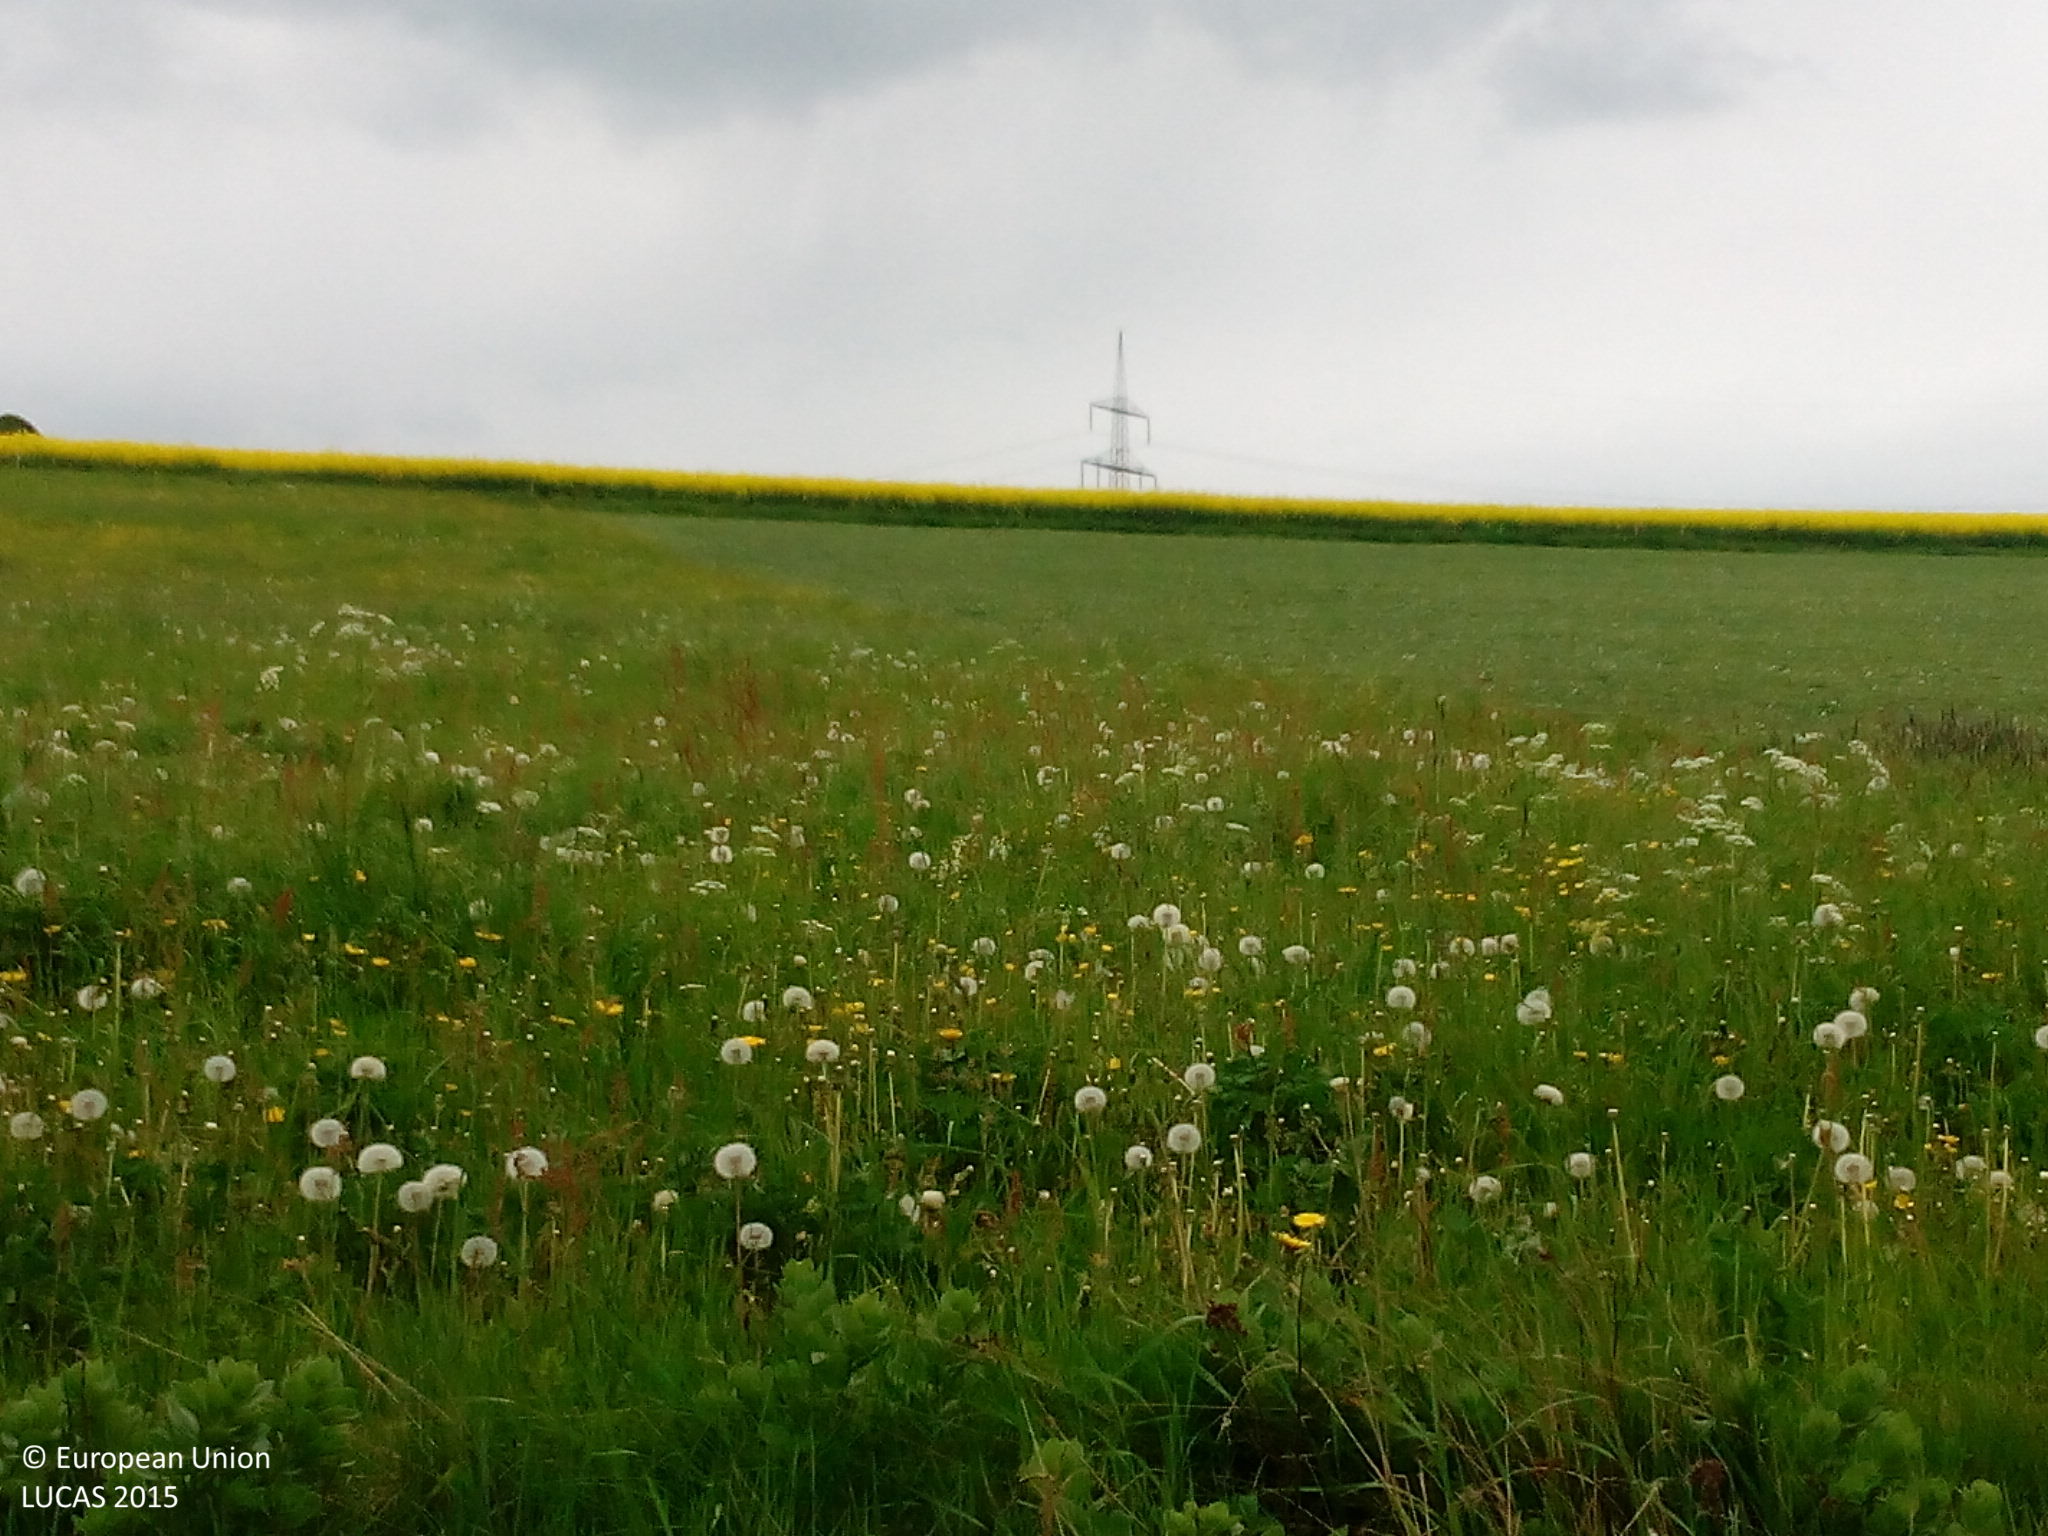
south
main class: Grassland
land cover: Grassland without tree/shrub cover
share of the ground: > 75 %
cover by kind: herbaceous plants 100 %
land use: Agriculture (excluding fallow land and kitchen gardens)
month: May
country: DE
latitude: 50.6670
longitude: 12.9853
